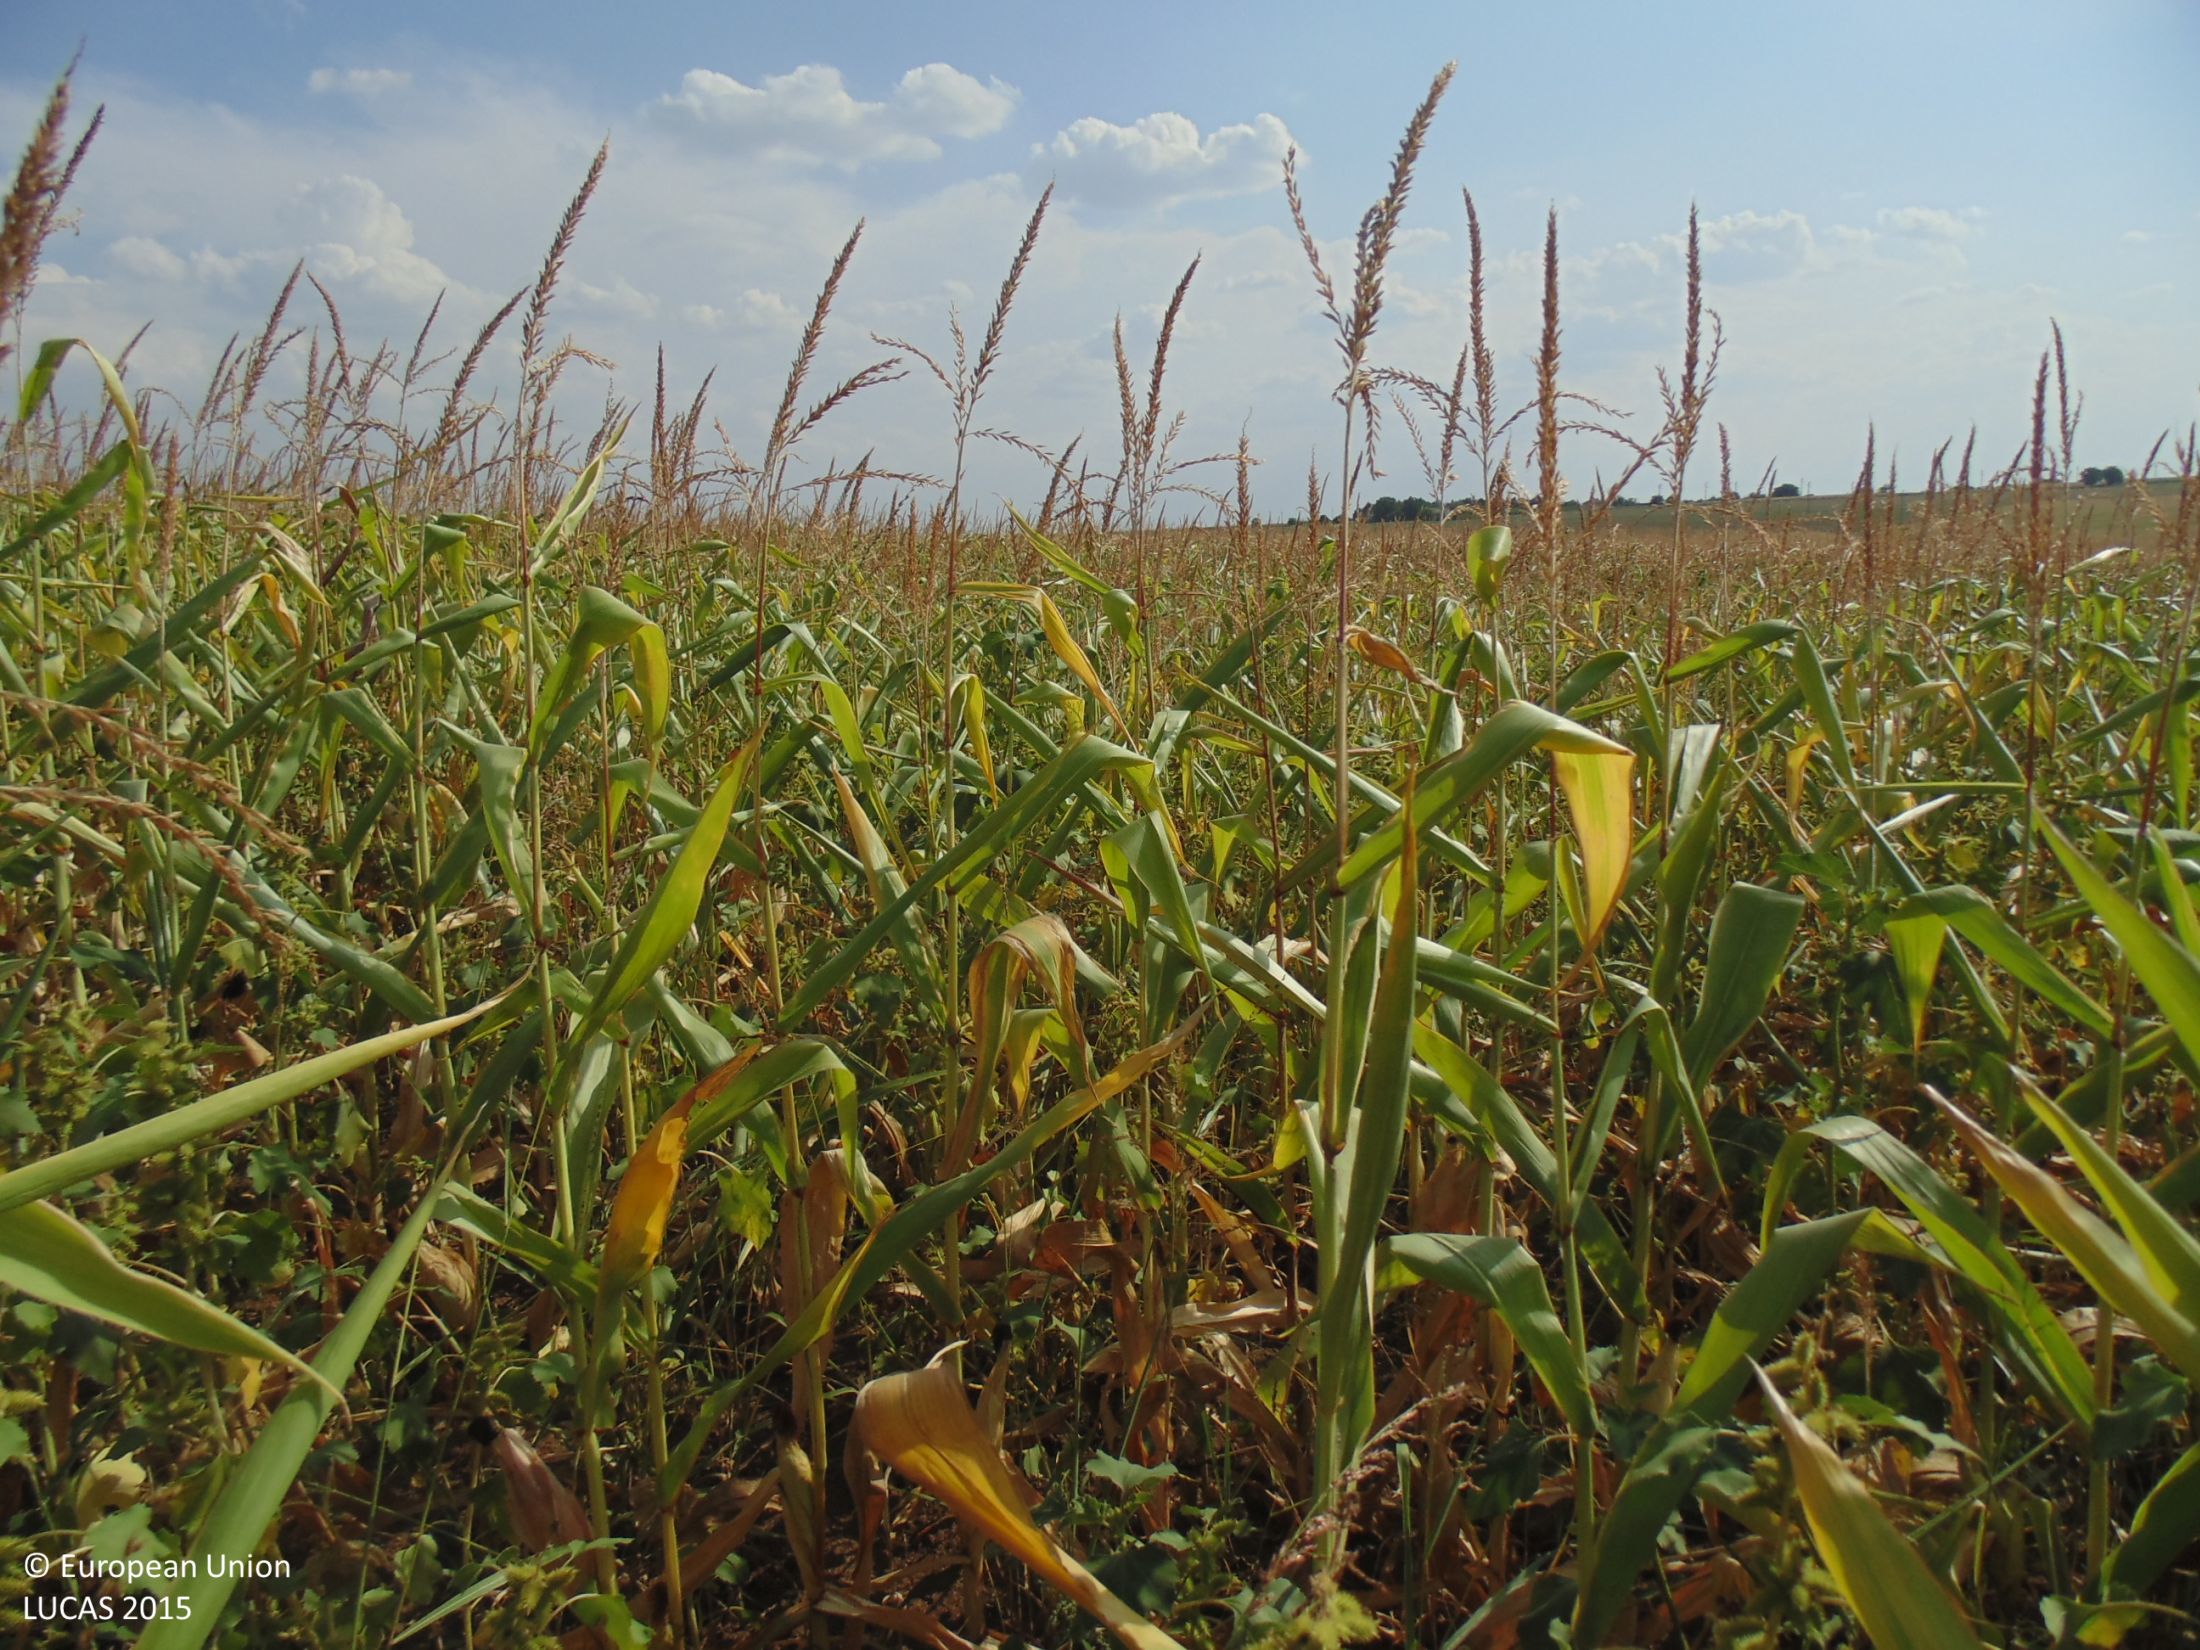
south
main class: Cropland
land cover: Maize
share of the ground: > 75 %
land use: Agriculture (excluding fallow land and kitchen gardens)
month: August
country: BG
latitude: 43.8379
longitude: 27.5357
